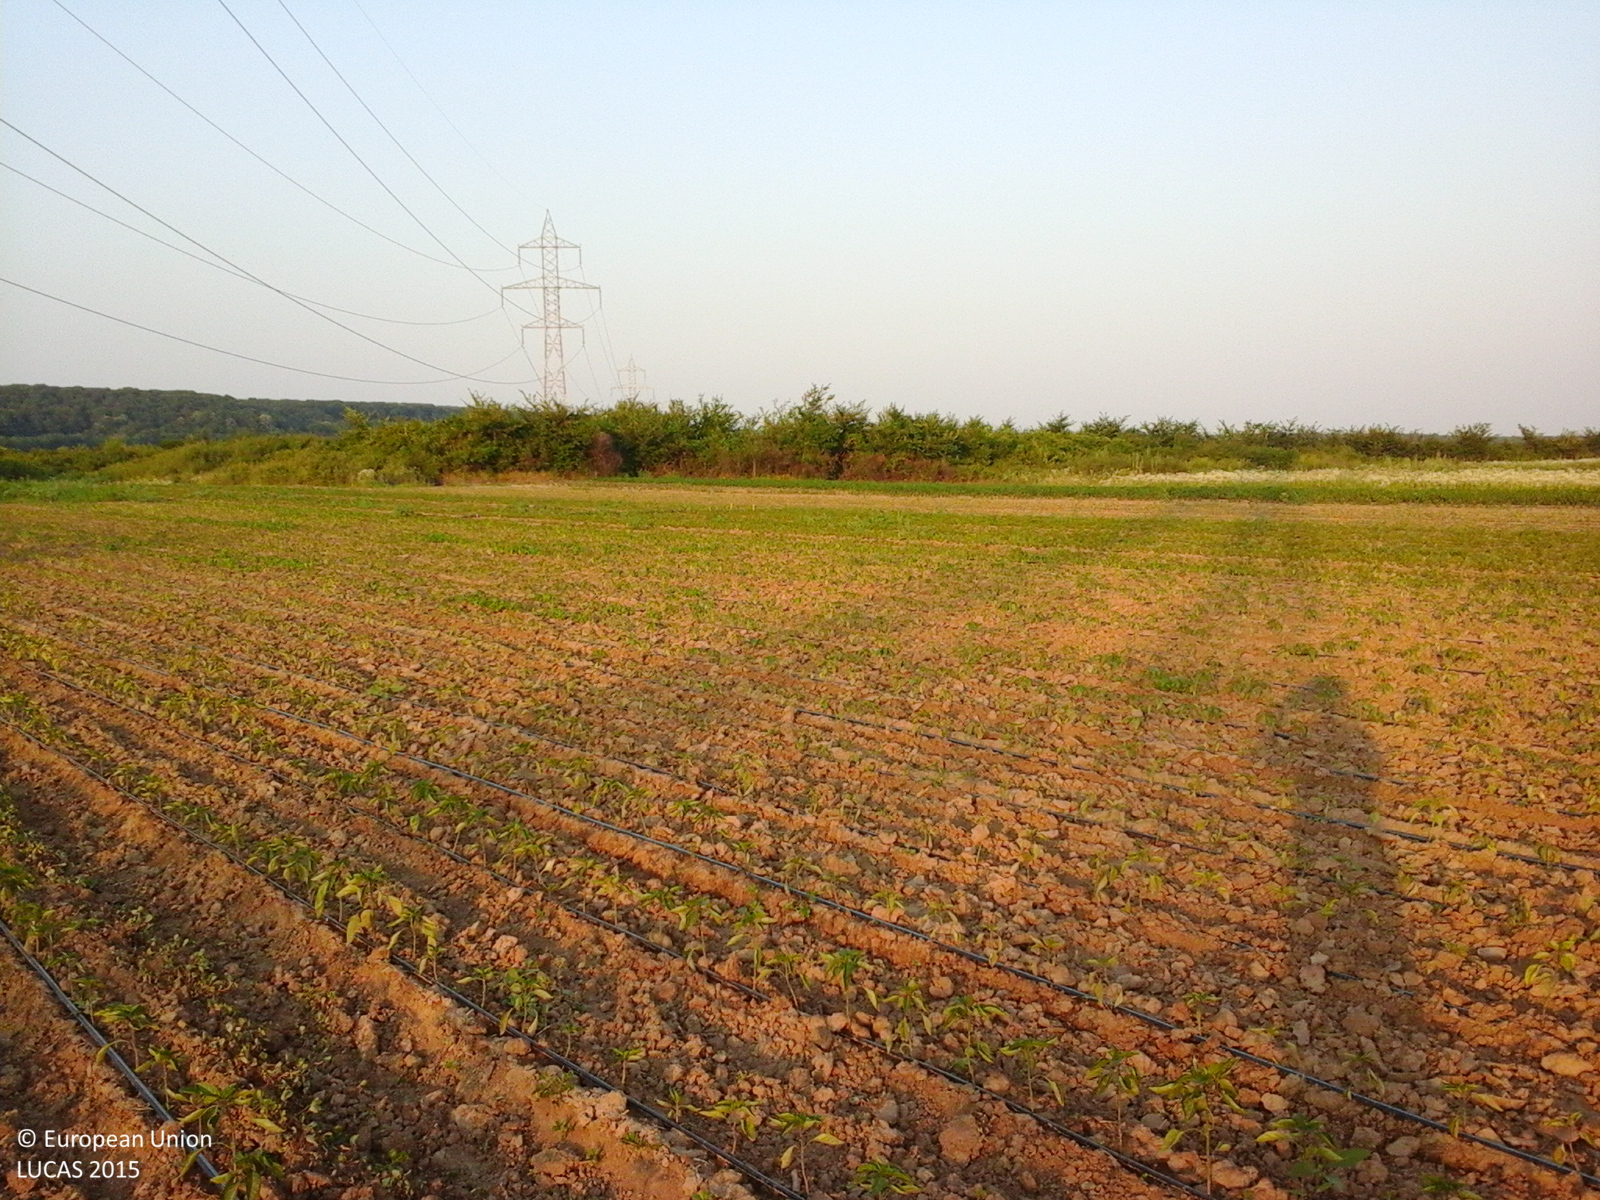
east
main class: Cropland
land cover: Other fresh vegetables
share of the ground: 10 - 25 %
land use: Agriculture (excluding fallow land and kitchen gardens)
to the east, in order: Other fresh vegetables; Electric lines; Other fresh vegetables; Tracks; Other fresh vegetables; Broadleaved woodland; Ditches and canals; Broadleaved woodland; Permanent crops (only in case pi); Tracks; Permanent crops (only in case pi)
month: July
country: RO
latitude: 44.8348
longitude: 25.6964
